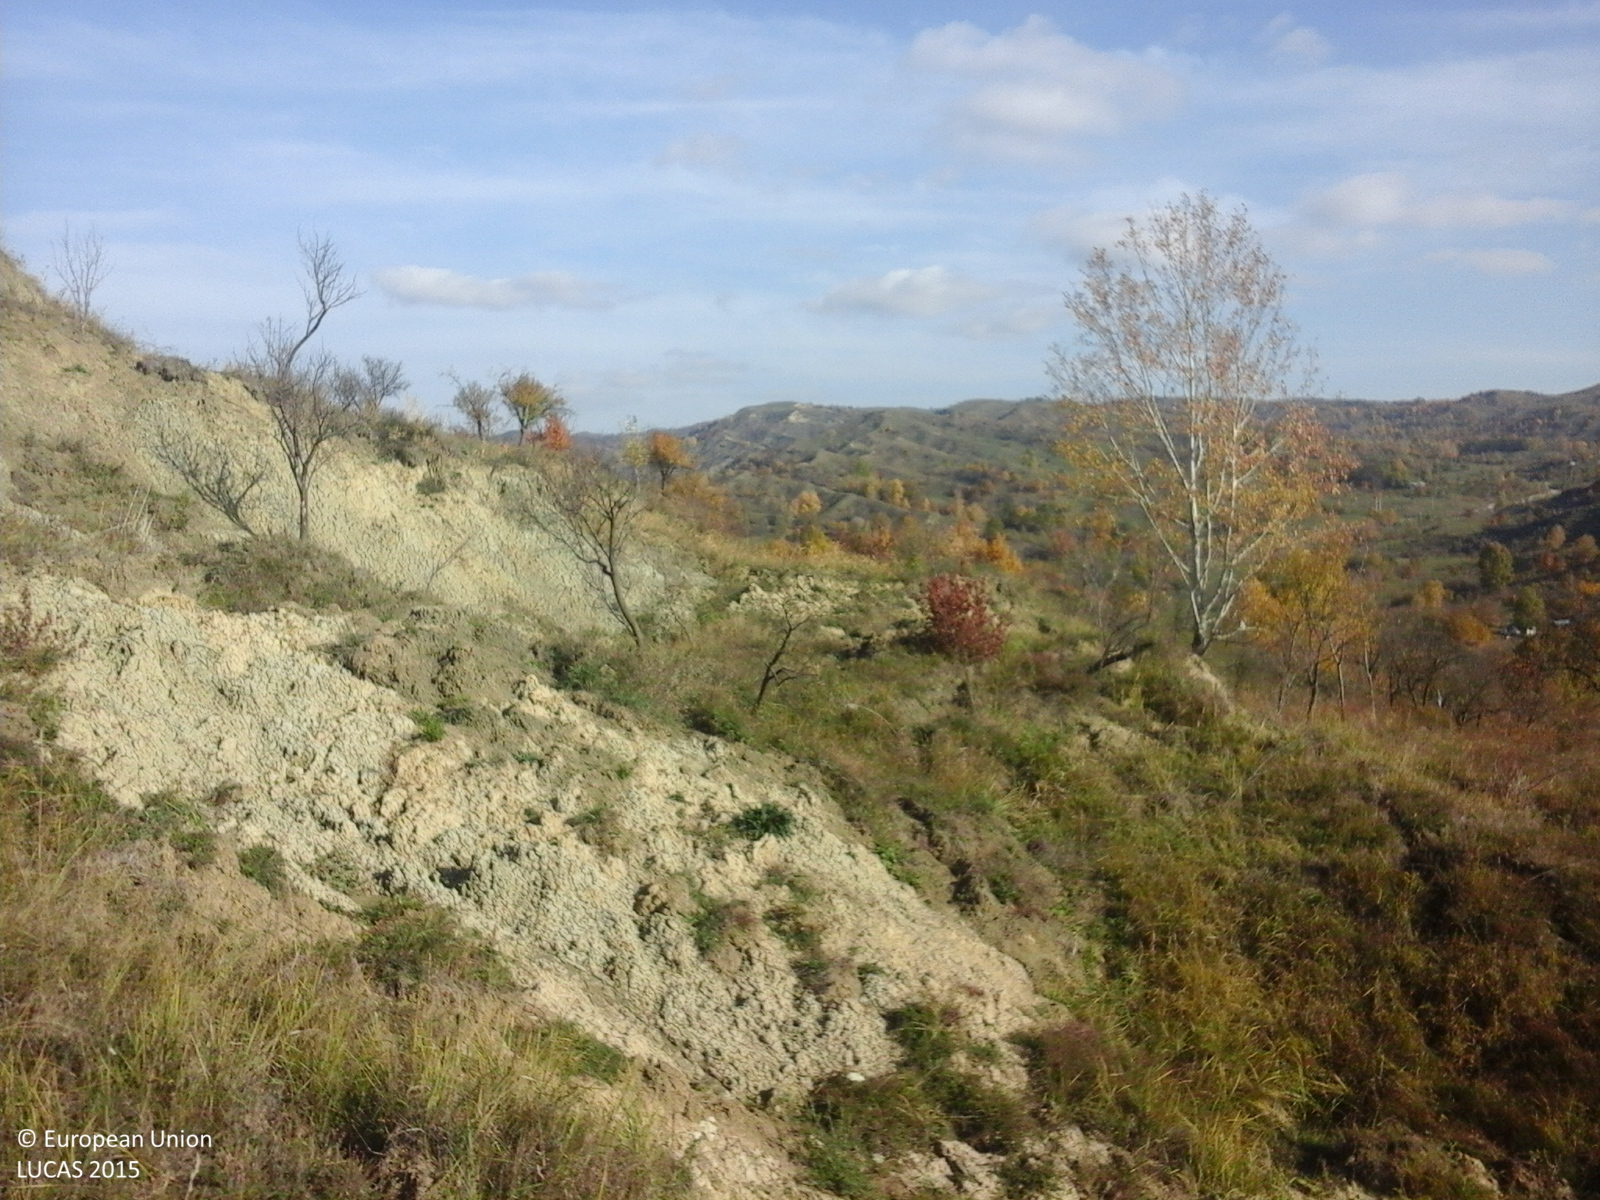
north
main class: Grassland
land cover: Grassland with sparse tree/shrub cover
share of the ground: > 75 %
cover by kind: herbaceous plants 85 %, shrubs 10 %, broadleaved forest trees 5 %
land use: Fallow land
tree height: < 5 m
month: October
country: RO
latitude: 45.6460
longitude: 26.9606
